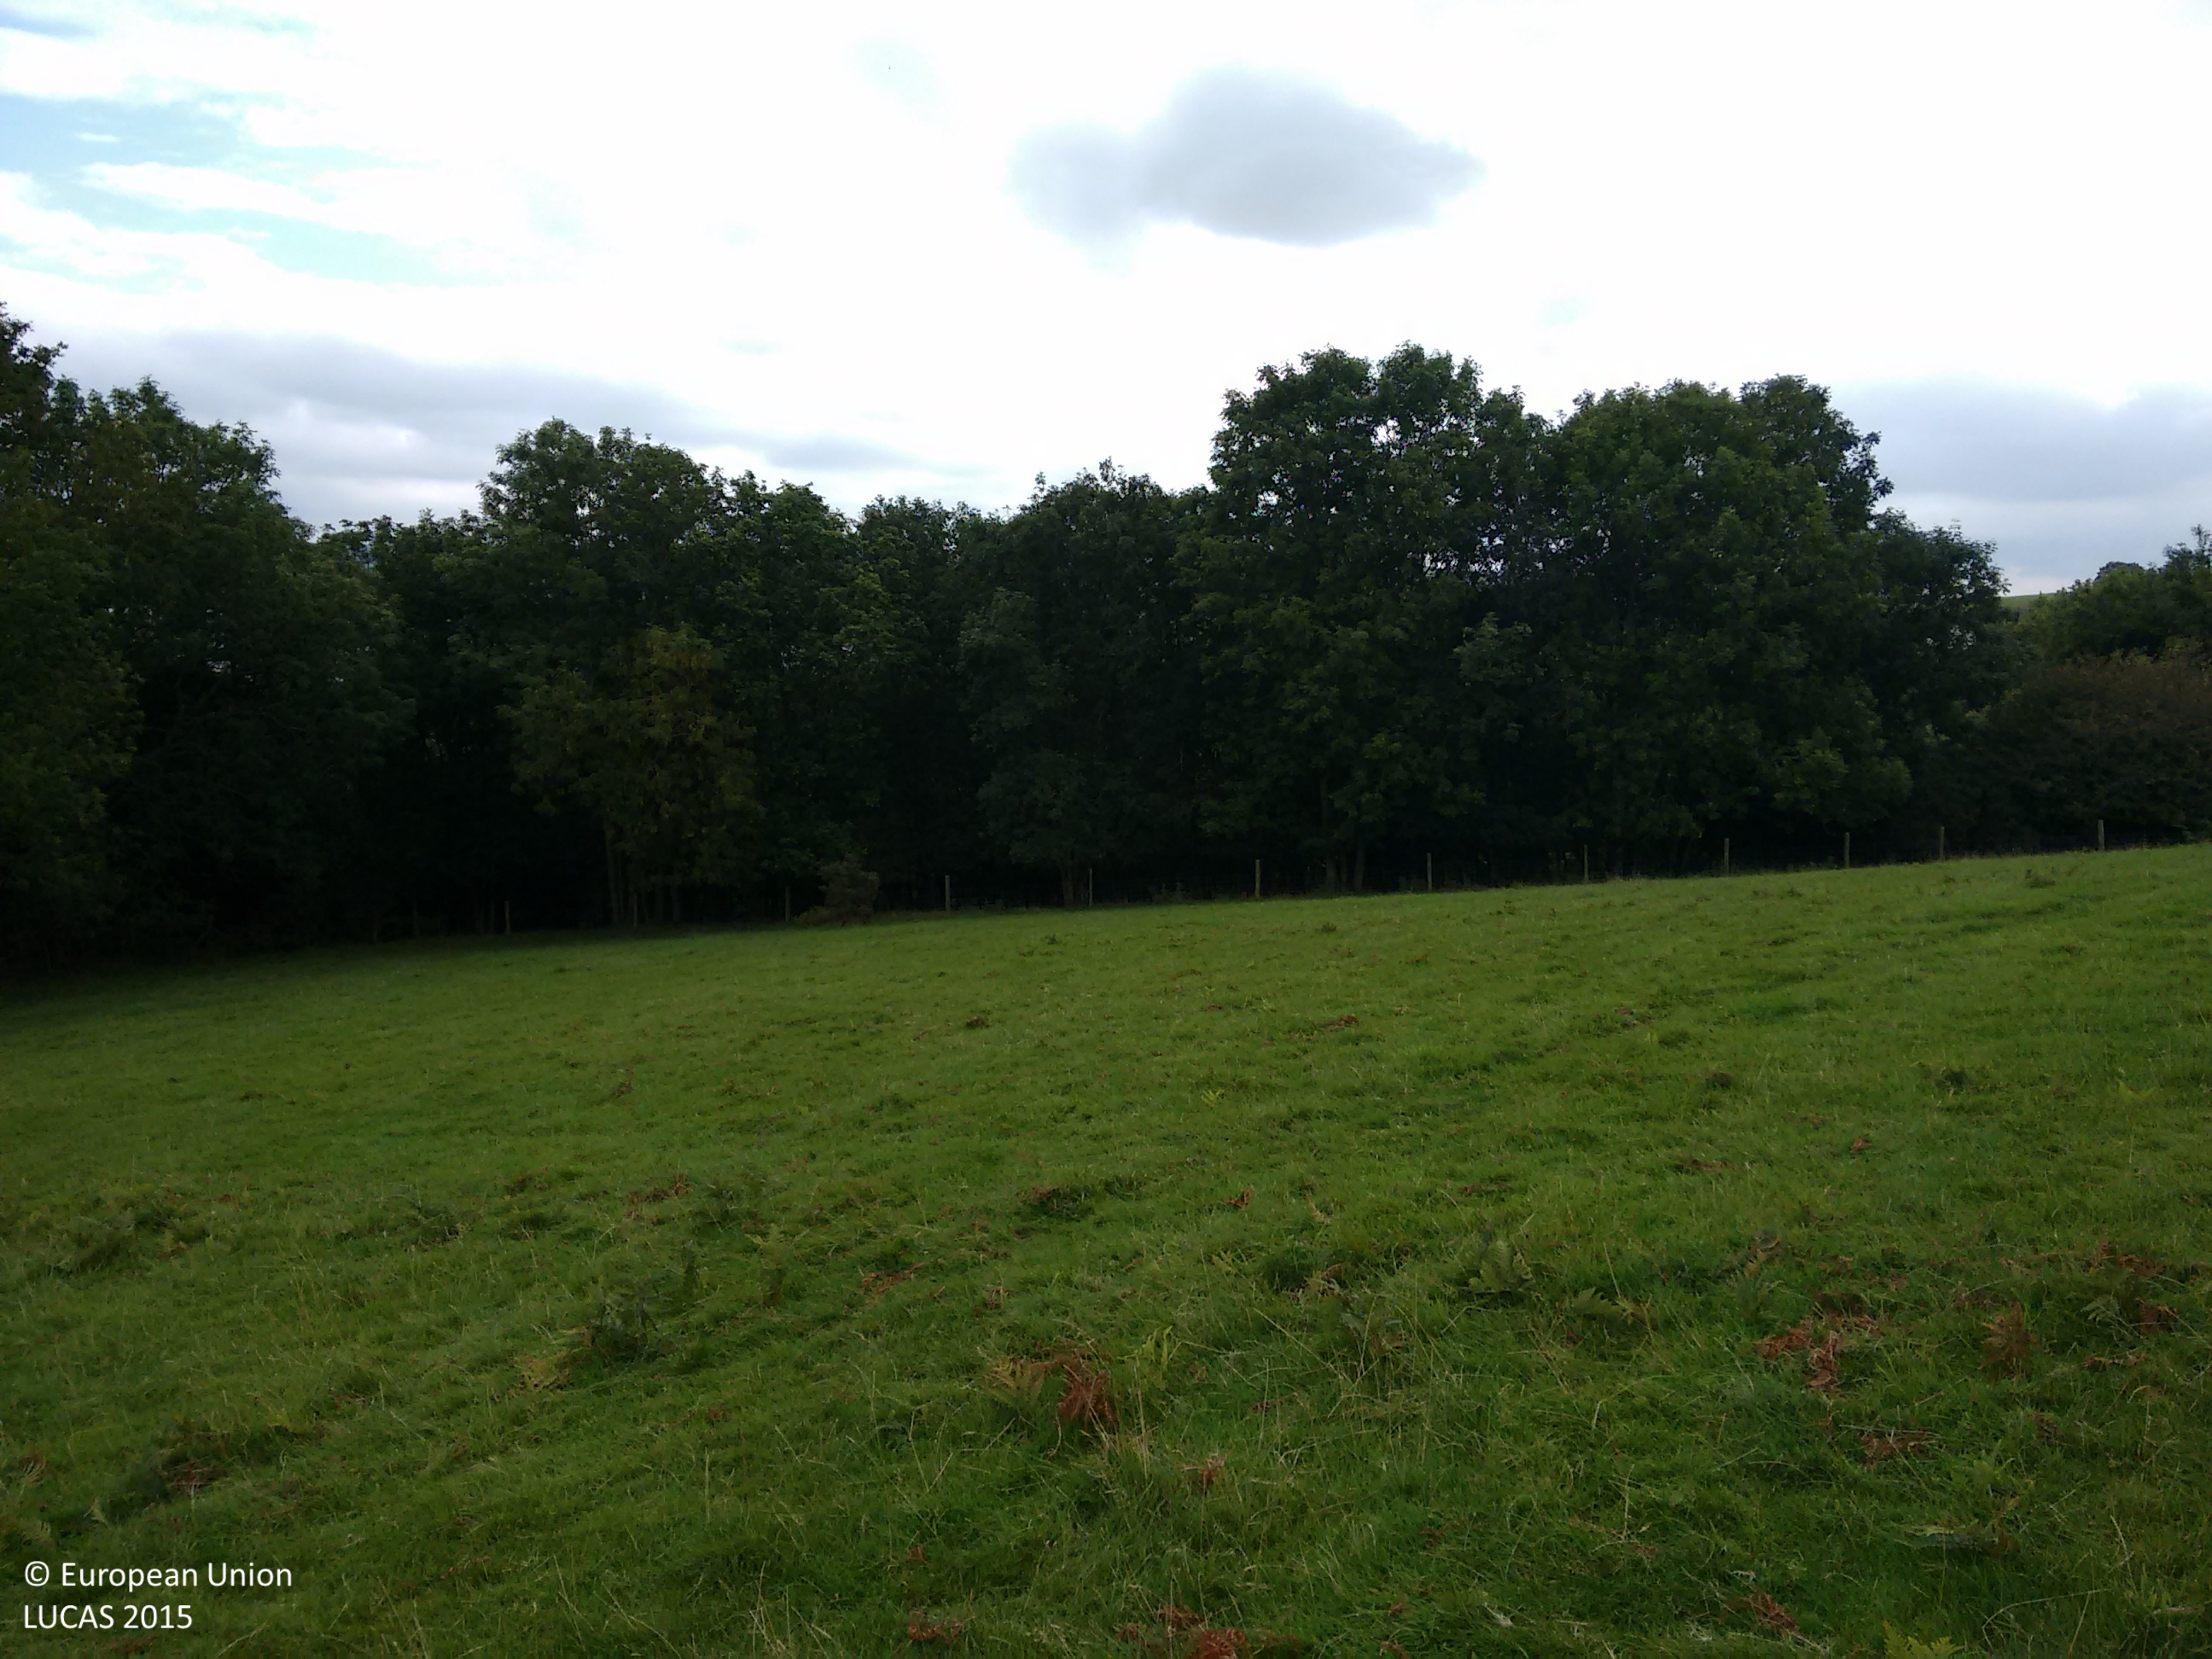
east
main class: Grassland
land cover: Grassland without tree/shrub cover
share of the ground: > 75 %
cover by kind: herbaceous plants 100 %
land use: Agriculture (excluding fallow land and kitchen gardens)
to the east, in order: Grassland without tree/shrub cover; Fences; Broadleaved woodland; Grassland without tree/shrub cover; Broadleaved woodland; Fences; Tracks; Broadleaved woodland; Paved roads, cycling and walking lanes; Broadleaved woodland
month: September
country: GB
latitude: 52.1320
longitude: -4.5549
